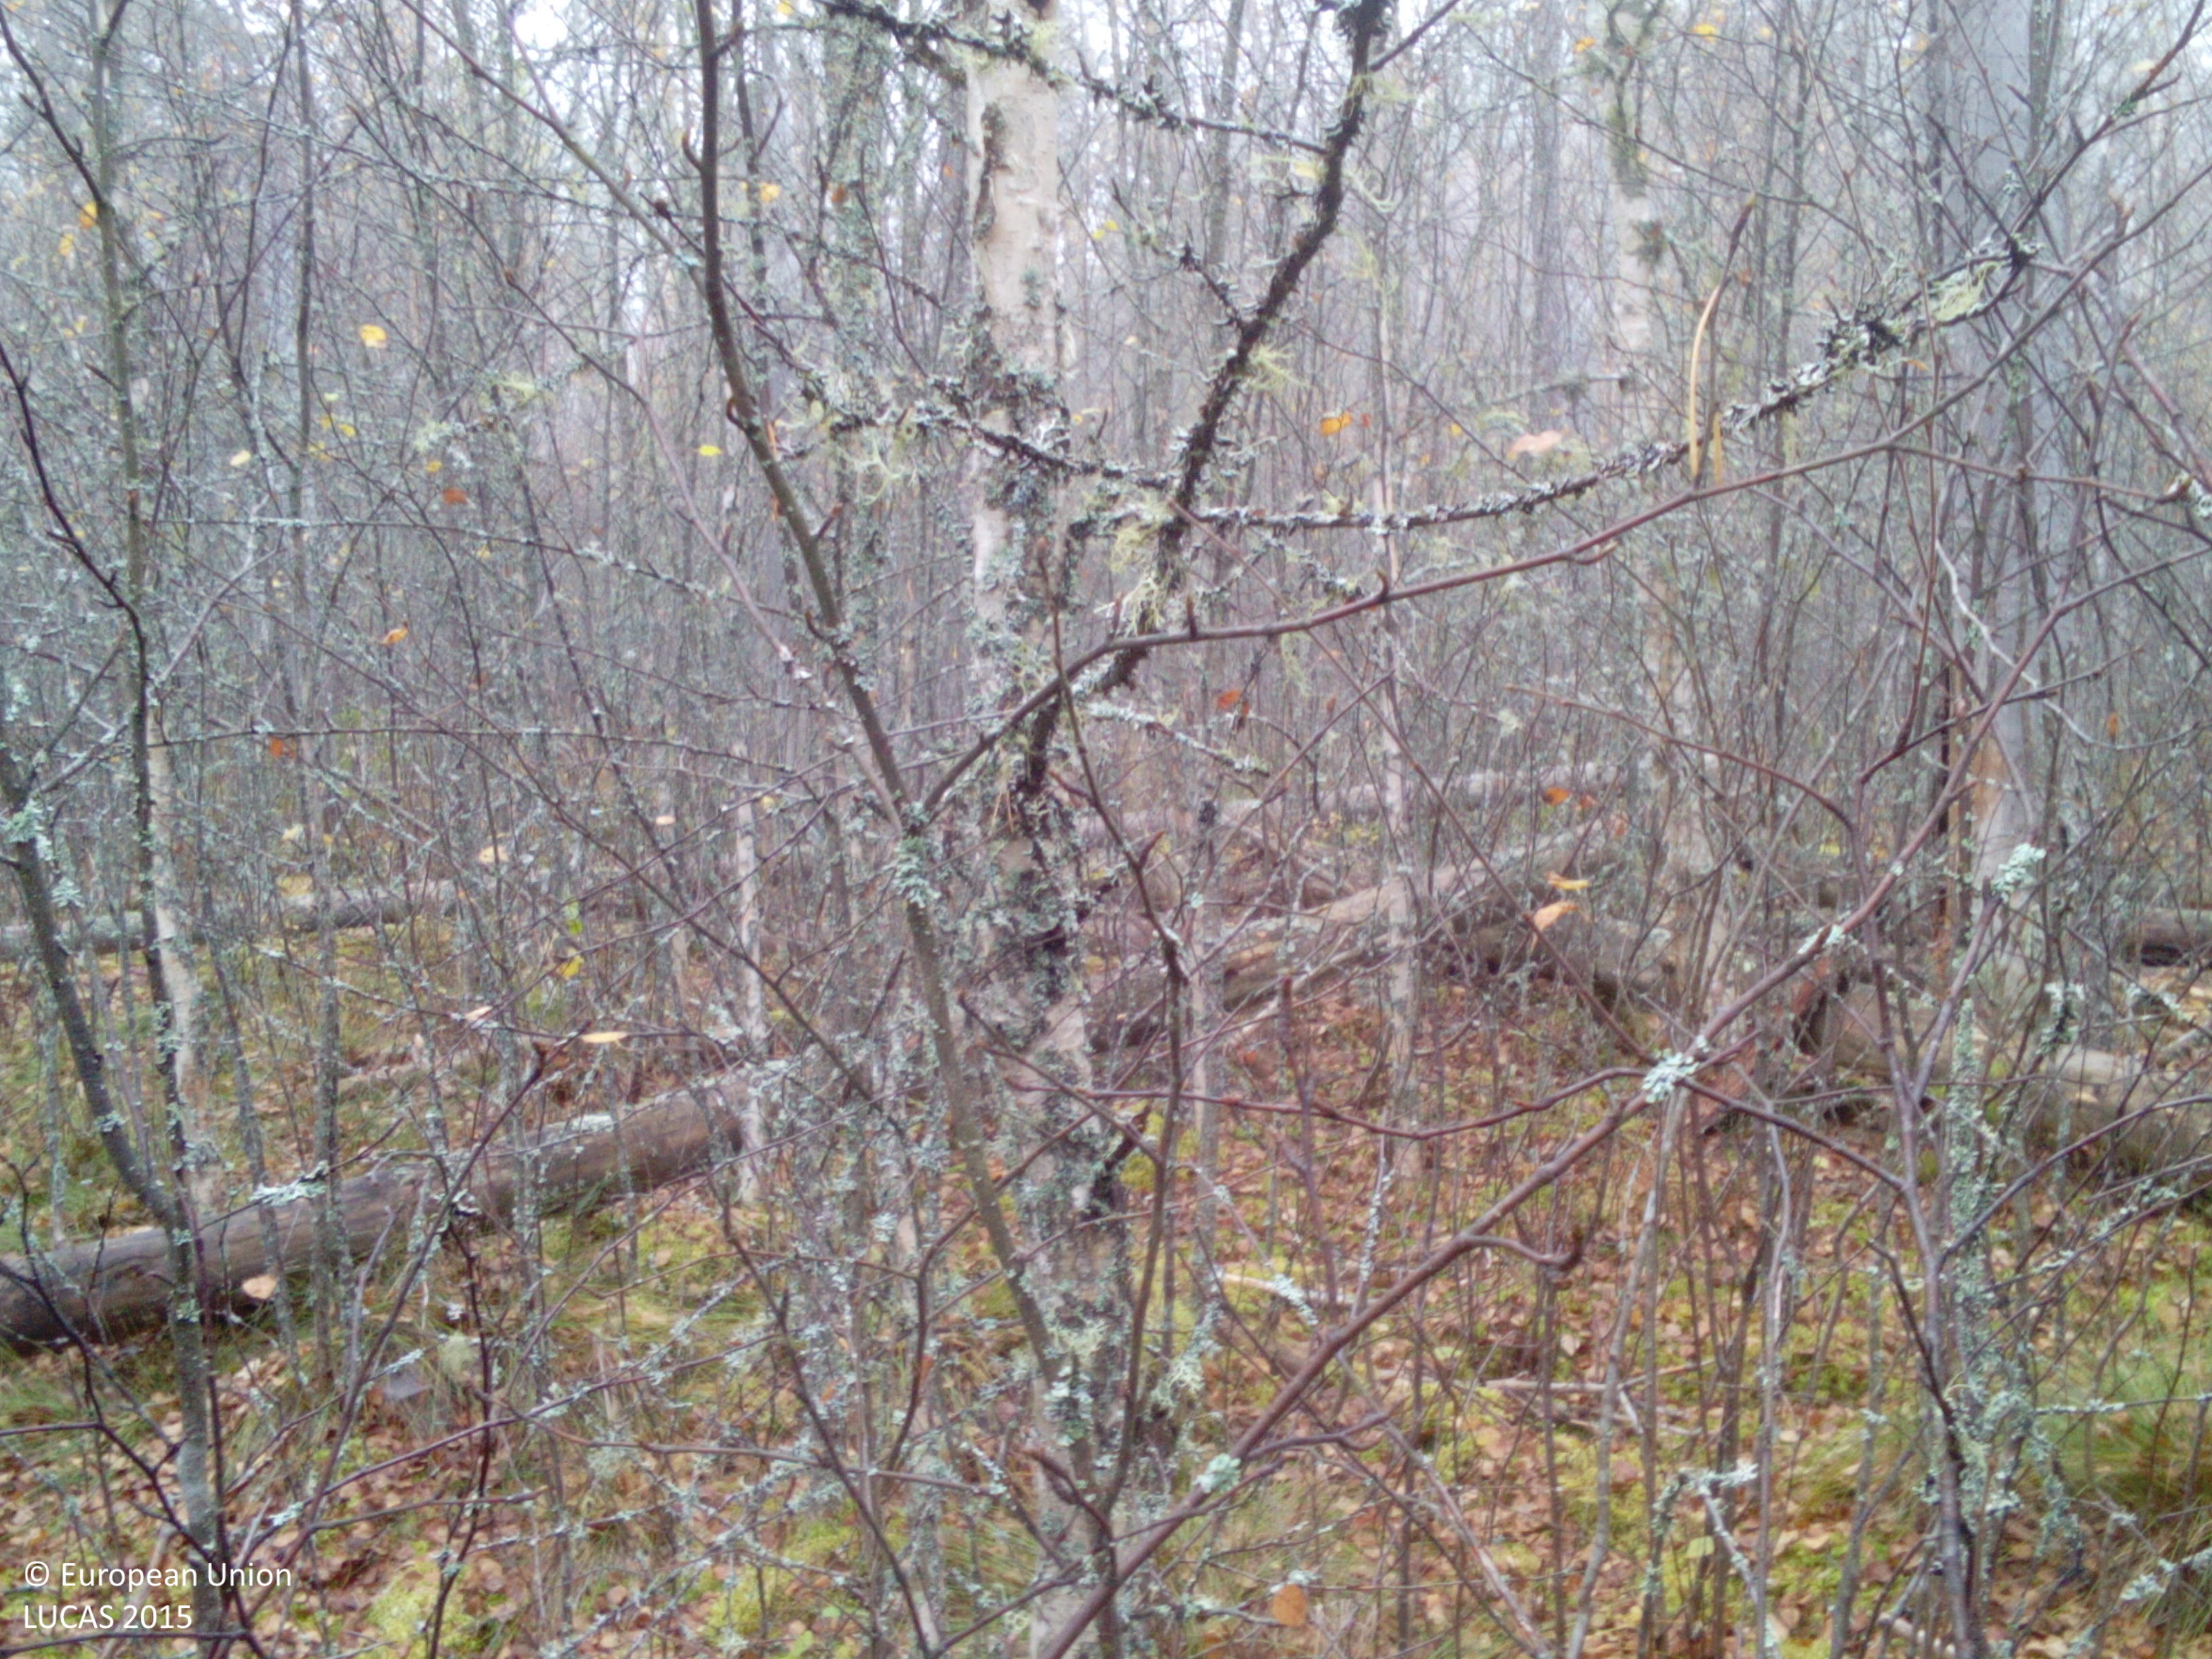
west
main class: Woodland
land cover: Broadleaved woodland
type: hemiboreal forest and nemoral coniferous forest and mixed broadleaved-coniferous forest
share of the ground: > 75 %
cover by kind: broadleaved forest trees 85 %, herbaceous plants 10 %, lichens and mosses 5 %
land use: Forestry
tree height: < 5 m
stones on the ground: < 10 %
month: October
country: SE
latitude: 58.9334
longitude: 16.4053
